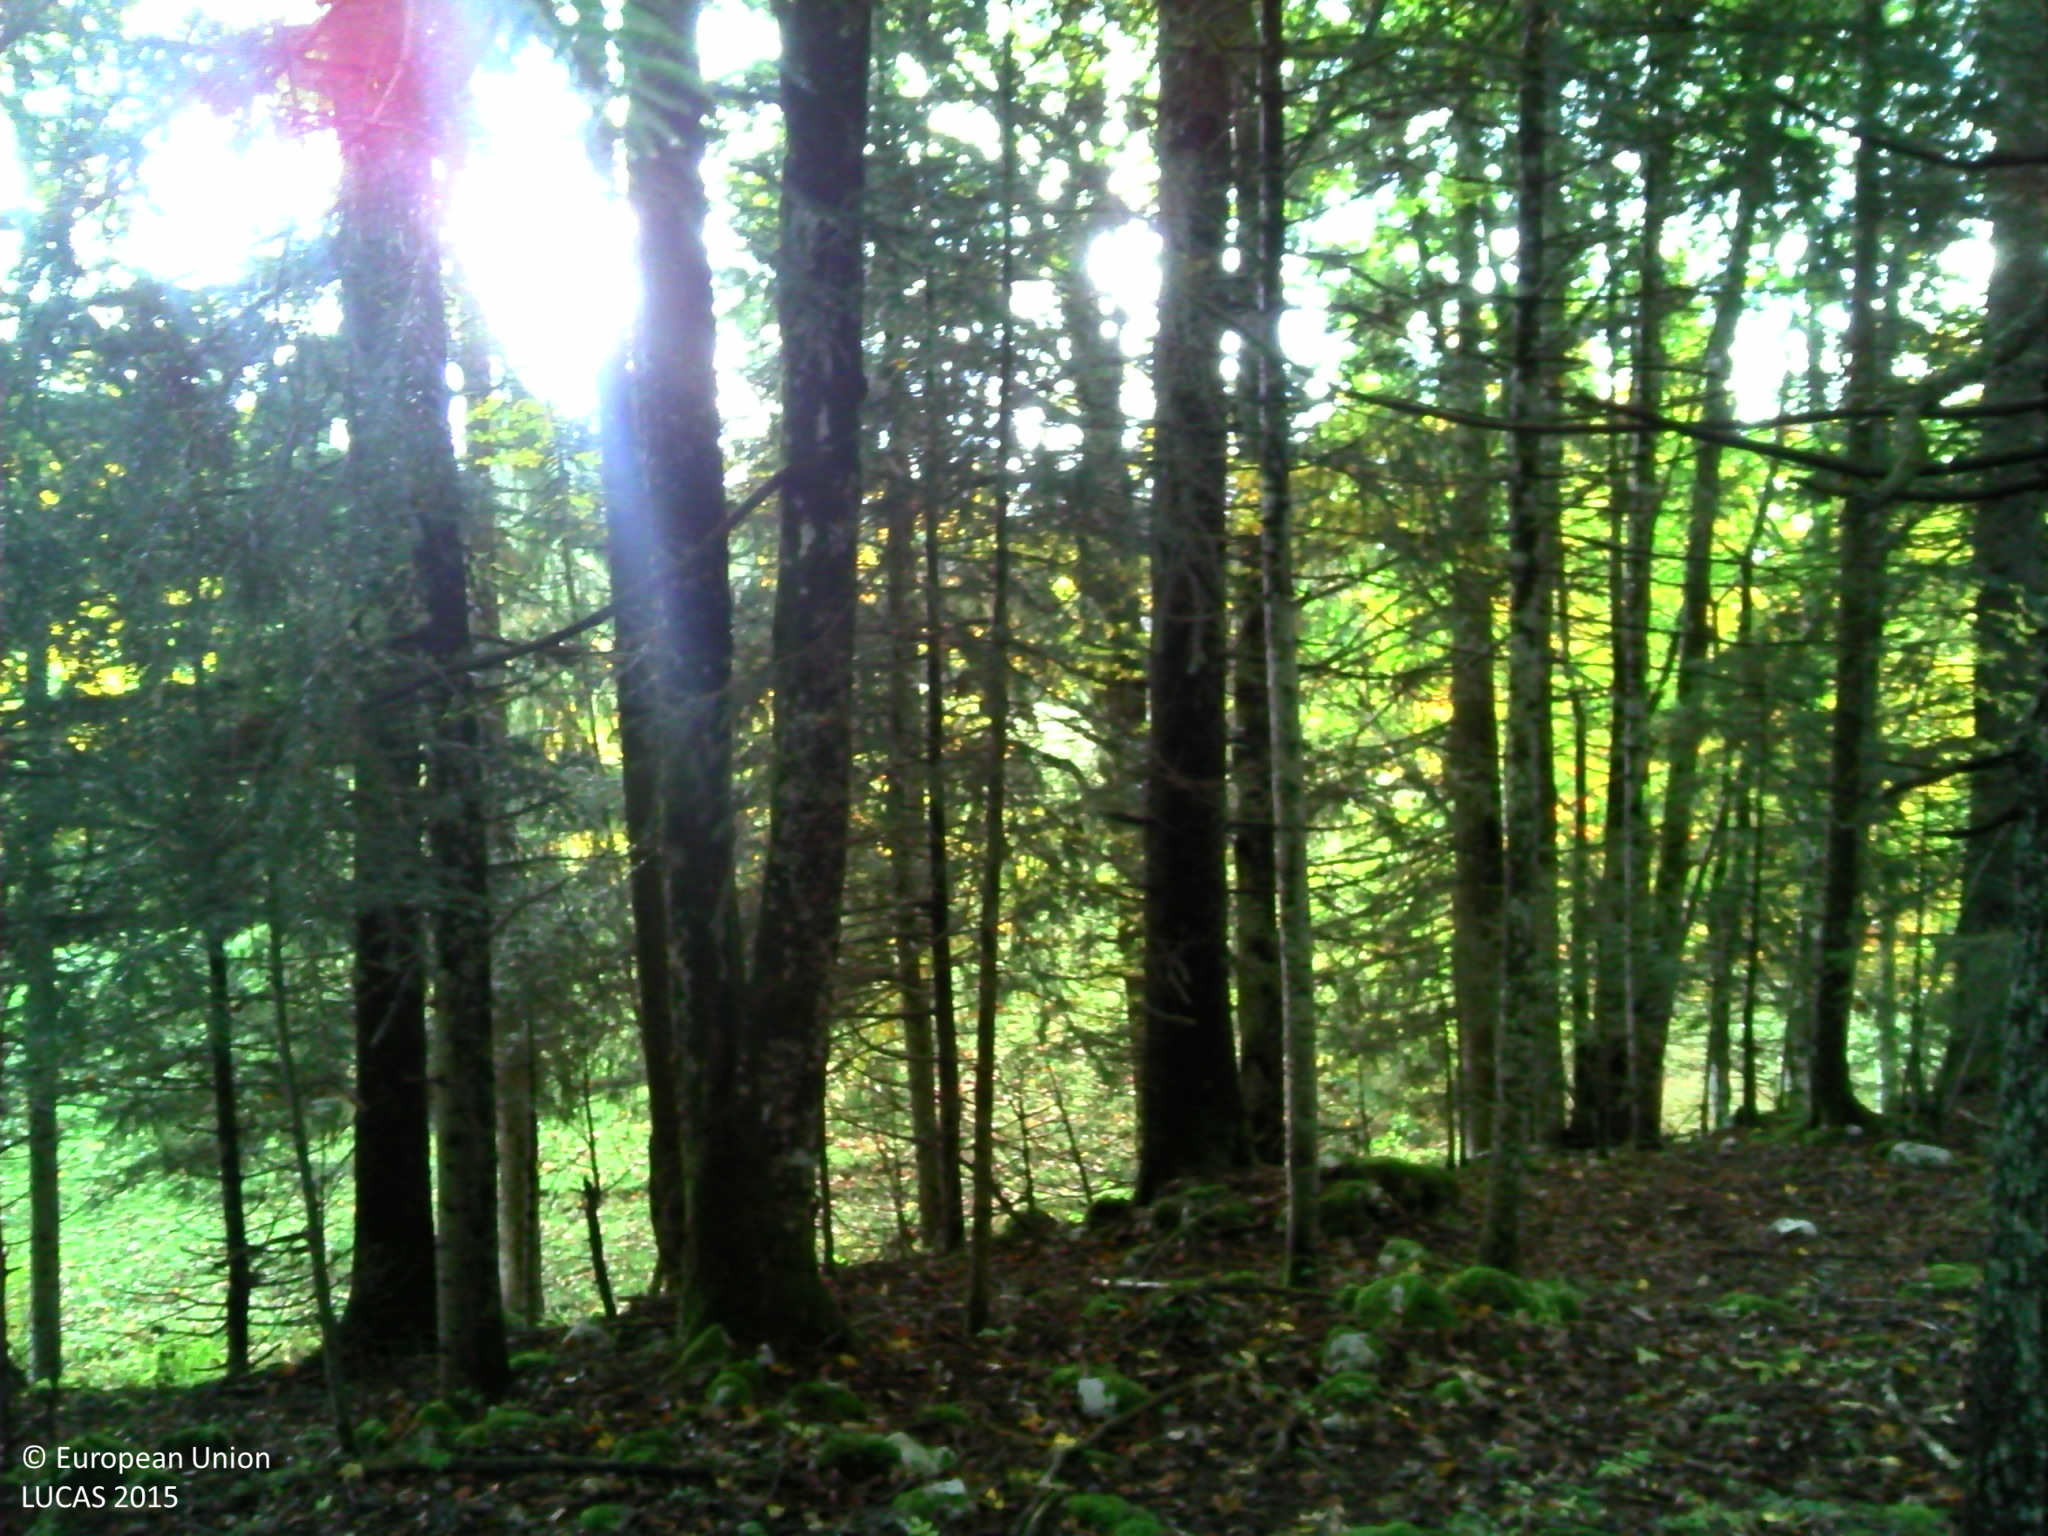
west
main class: Woodland
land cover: Spruce dominated mixed woodland
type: mountainous beech forest
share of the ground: > 75 %
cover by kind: coniferous forest trees 60 %, broadleaved forest trees 40 %
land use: Agriculture (excluding fallow land and kitchen gardens)
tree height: > 5 m
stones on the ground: < 10 %
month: October
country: FR
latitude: 46.7388
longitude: 6.3250
